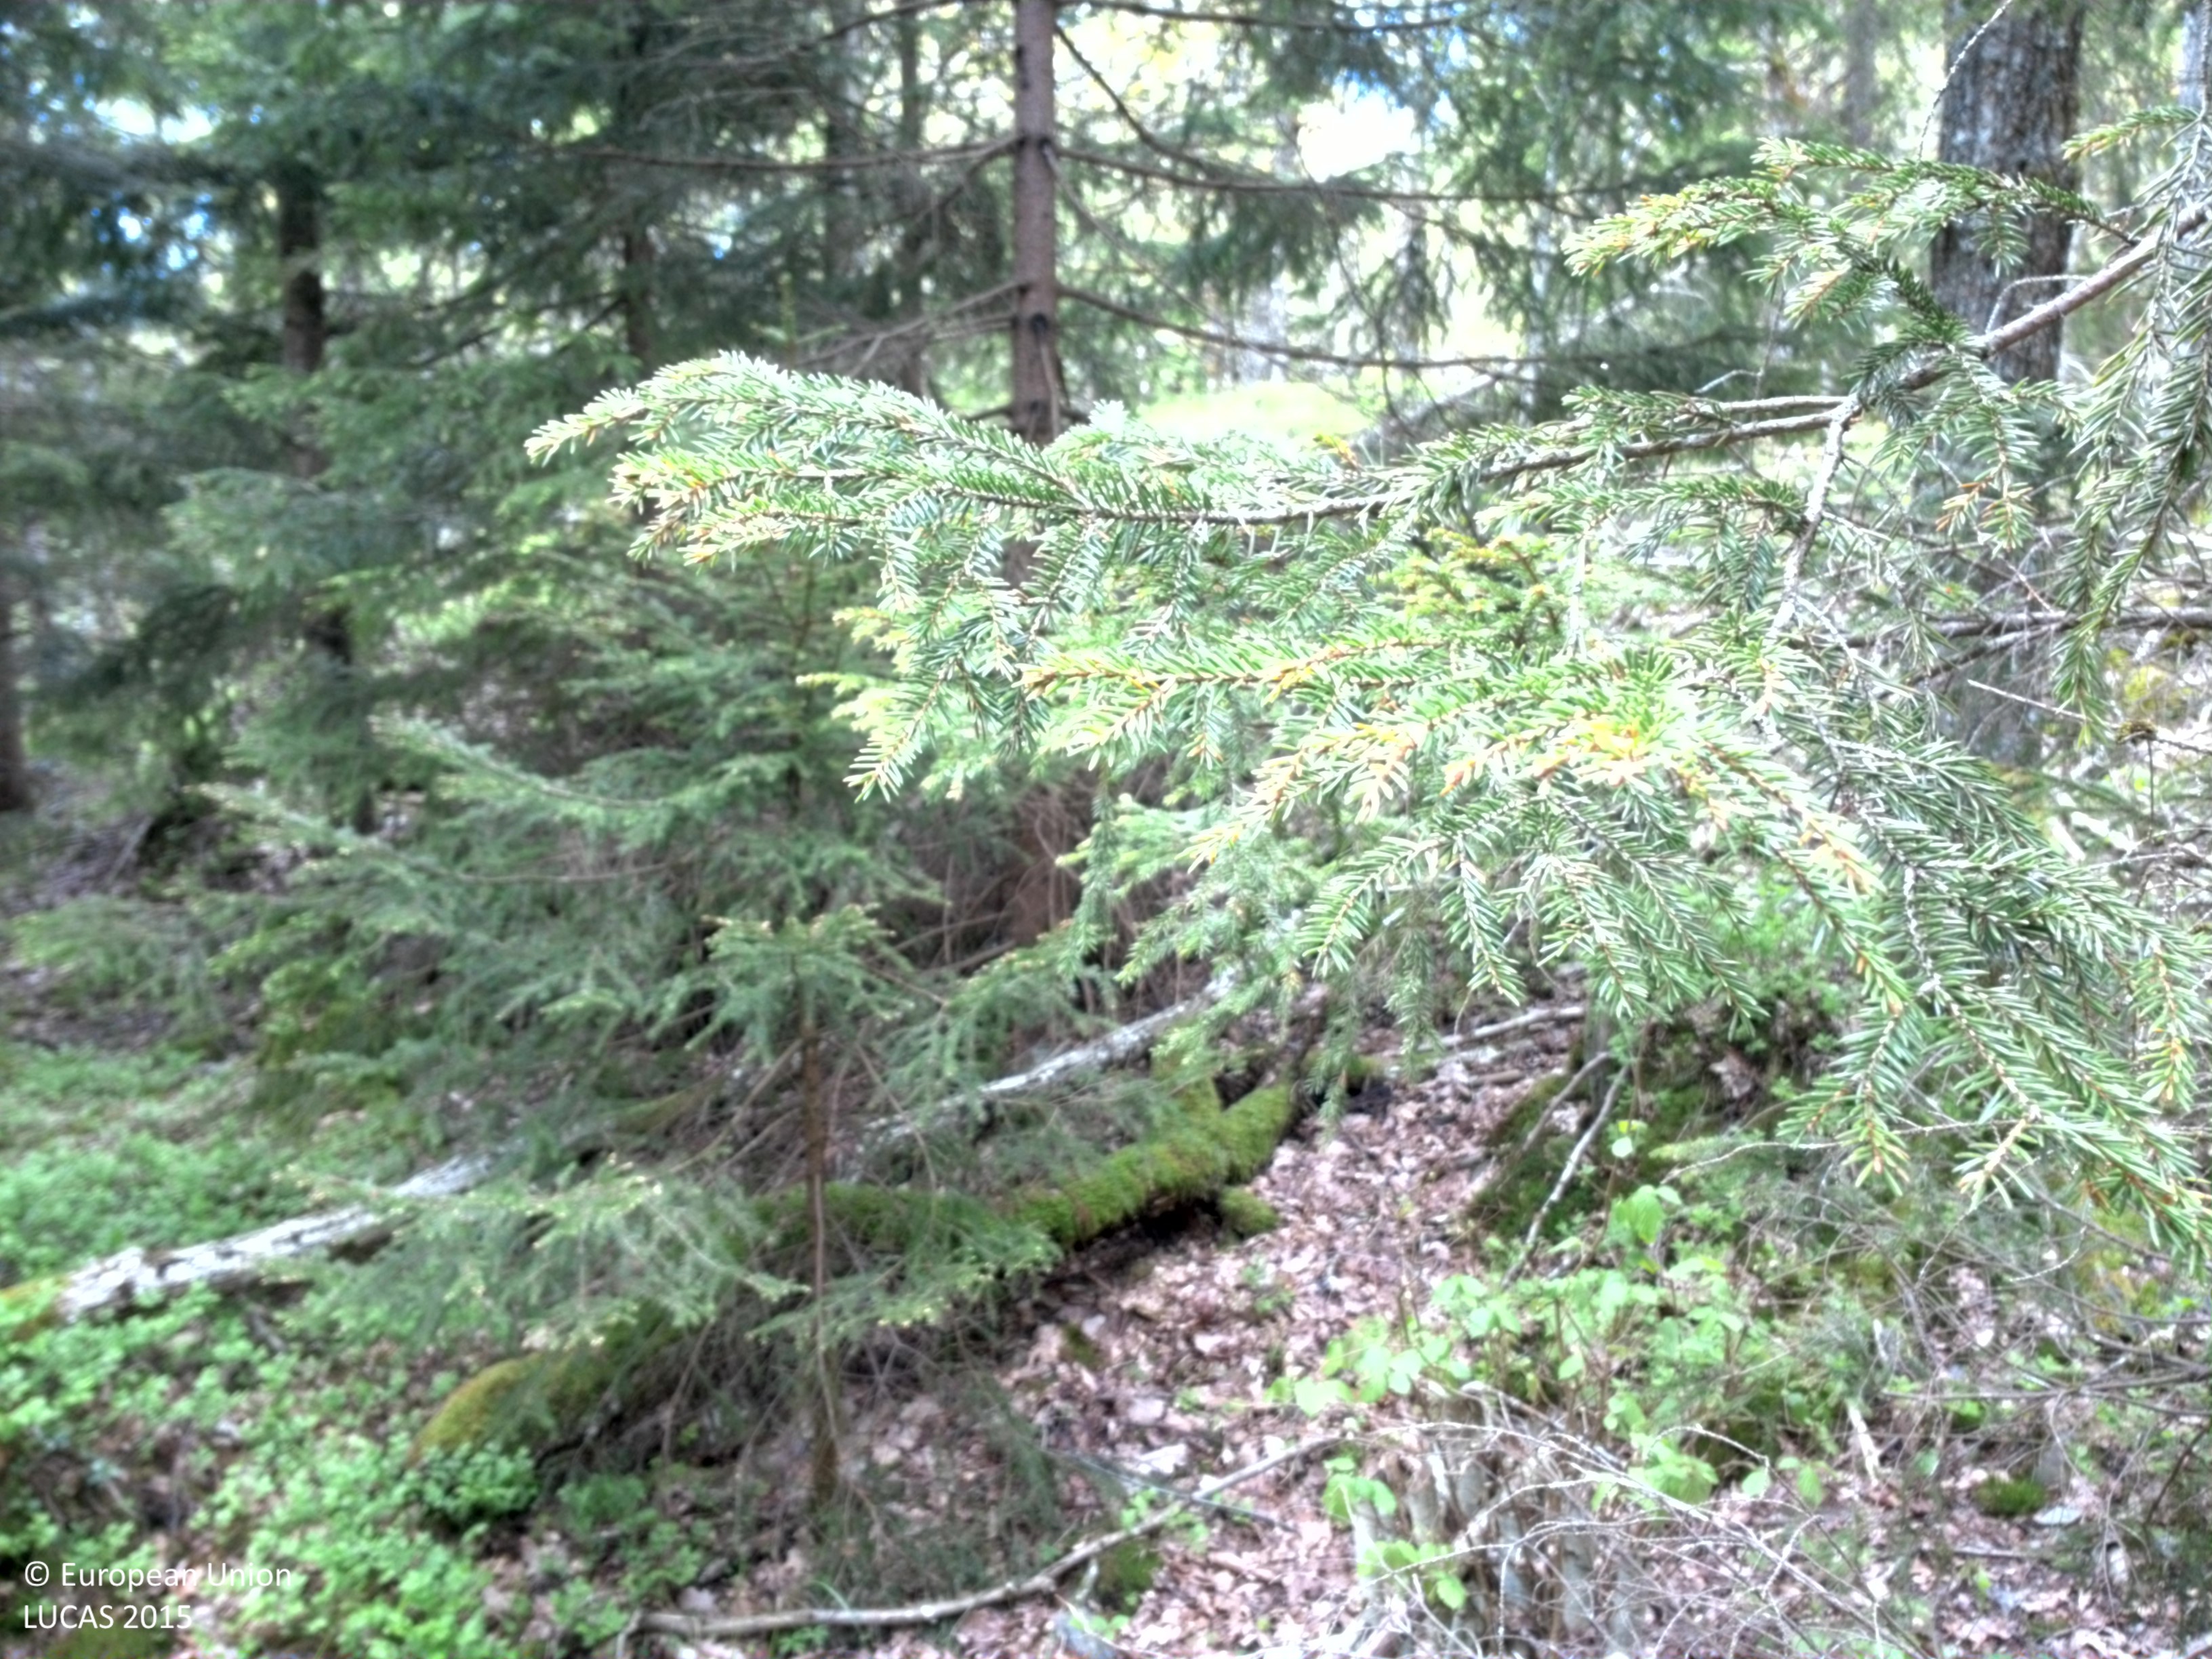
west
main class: Woodland
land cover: Spruce dominated mixed woodland
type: boreal forest
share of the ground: > 75 %
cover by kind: coniferous forest trees 60 %, broadleaved forest trees 25 %, herbaceous plants 15 %
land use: Forestry
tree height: > 5 m
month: May
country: SE
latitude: 58.6325
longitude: 12.2516
